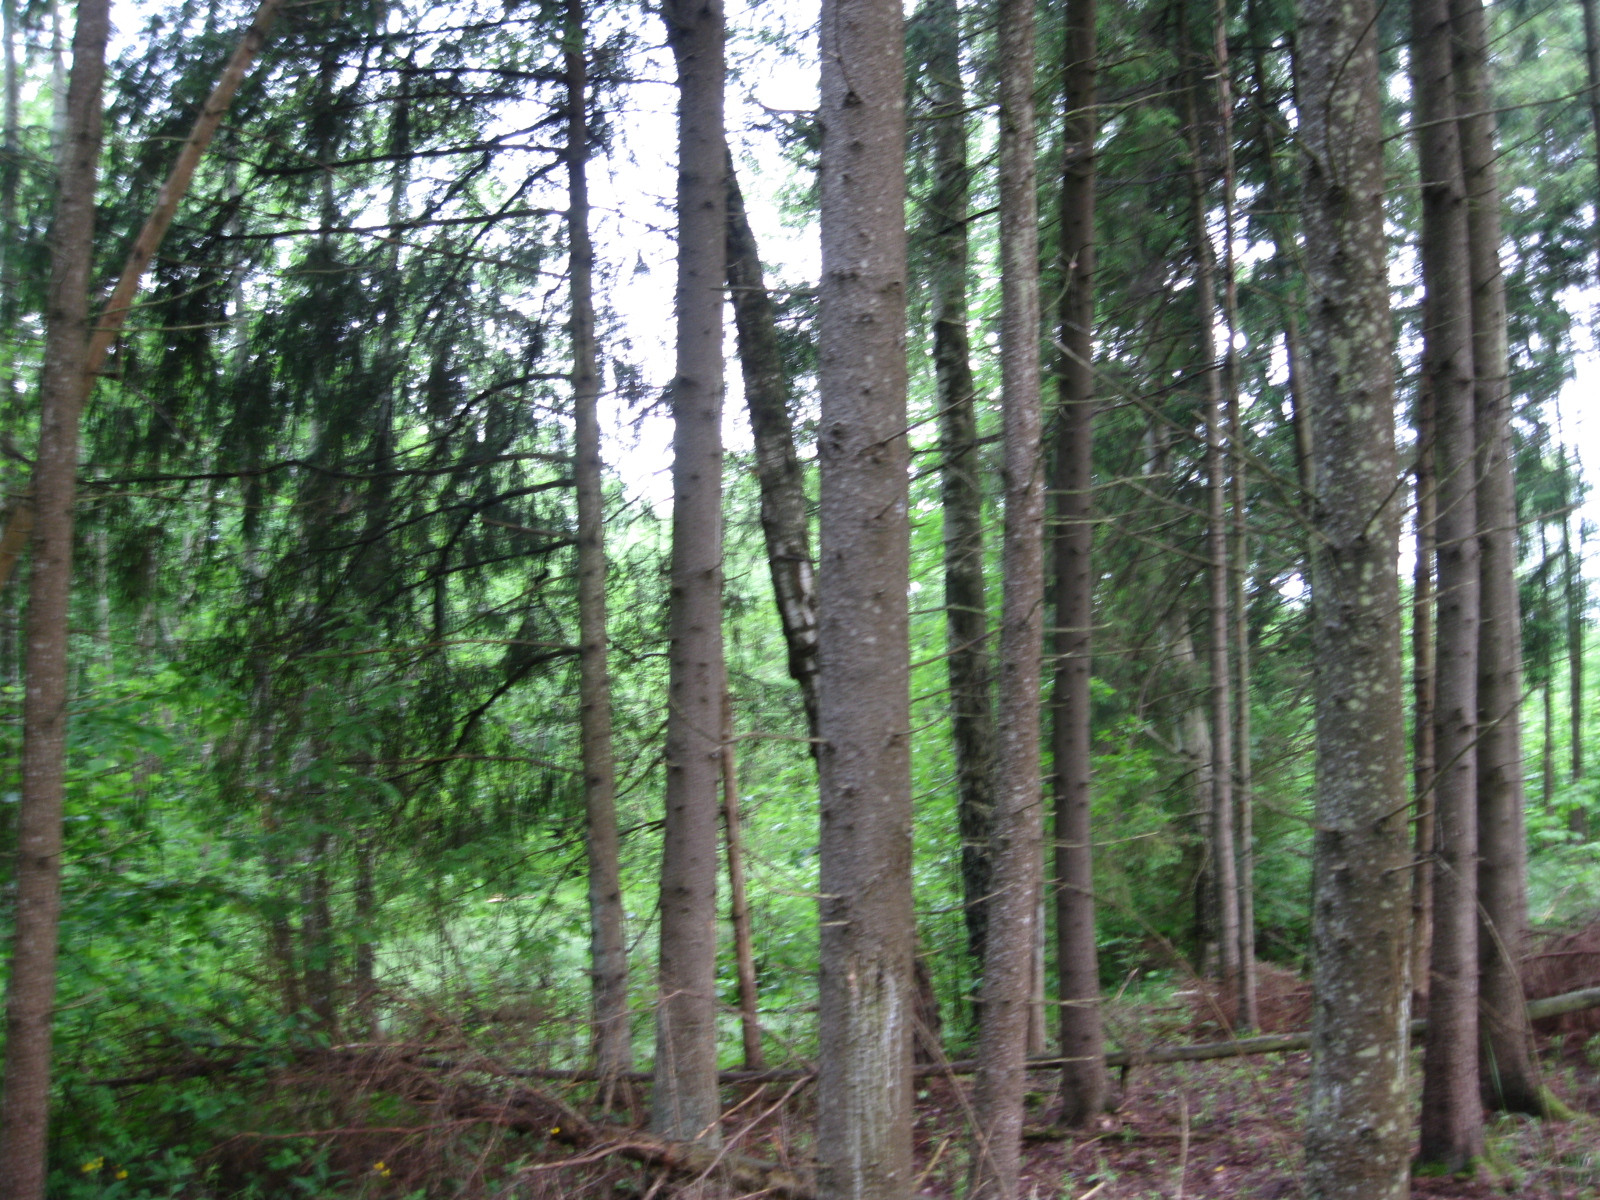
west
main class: Woodland
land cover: Spruce dominated mixed woodland
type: hemiboreal forest and nemoral coniferous forest and mixed broadleaved-coniferous forest
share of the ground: > 75 %
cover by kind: coniferous forest trees 50 %, broadleaved forest trees 30 %, herbaceous plants 20 %
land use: Forestry
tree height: > 5 m
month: June
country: LT
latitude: 55.4033
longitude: 23.7765
